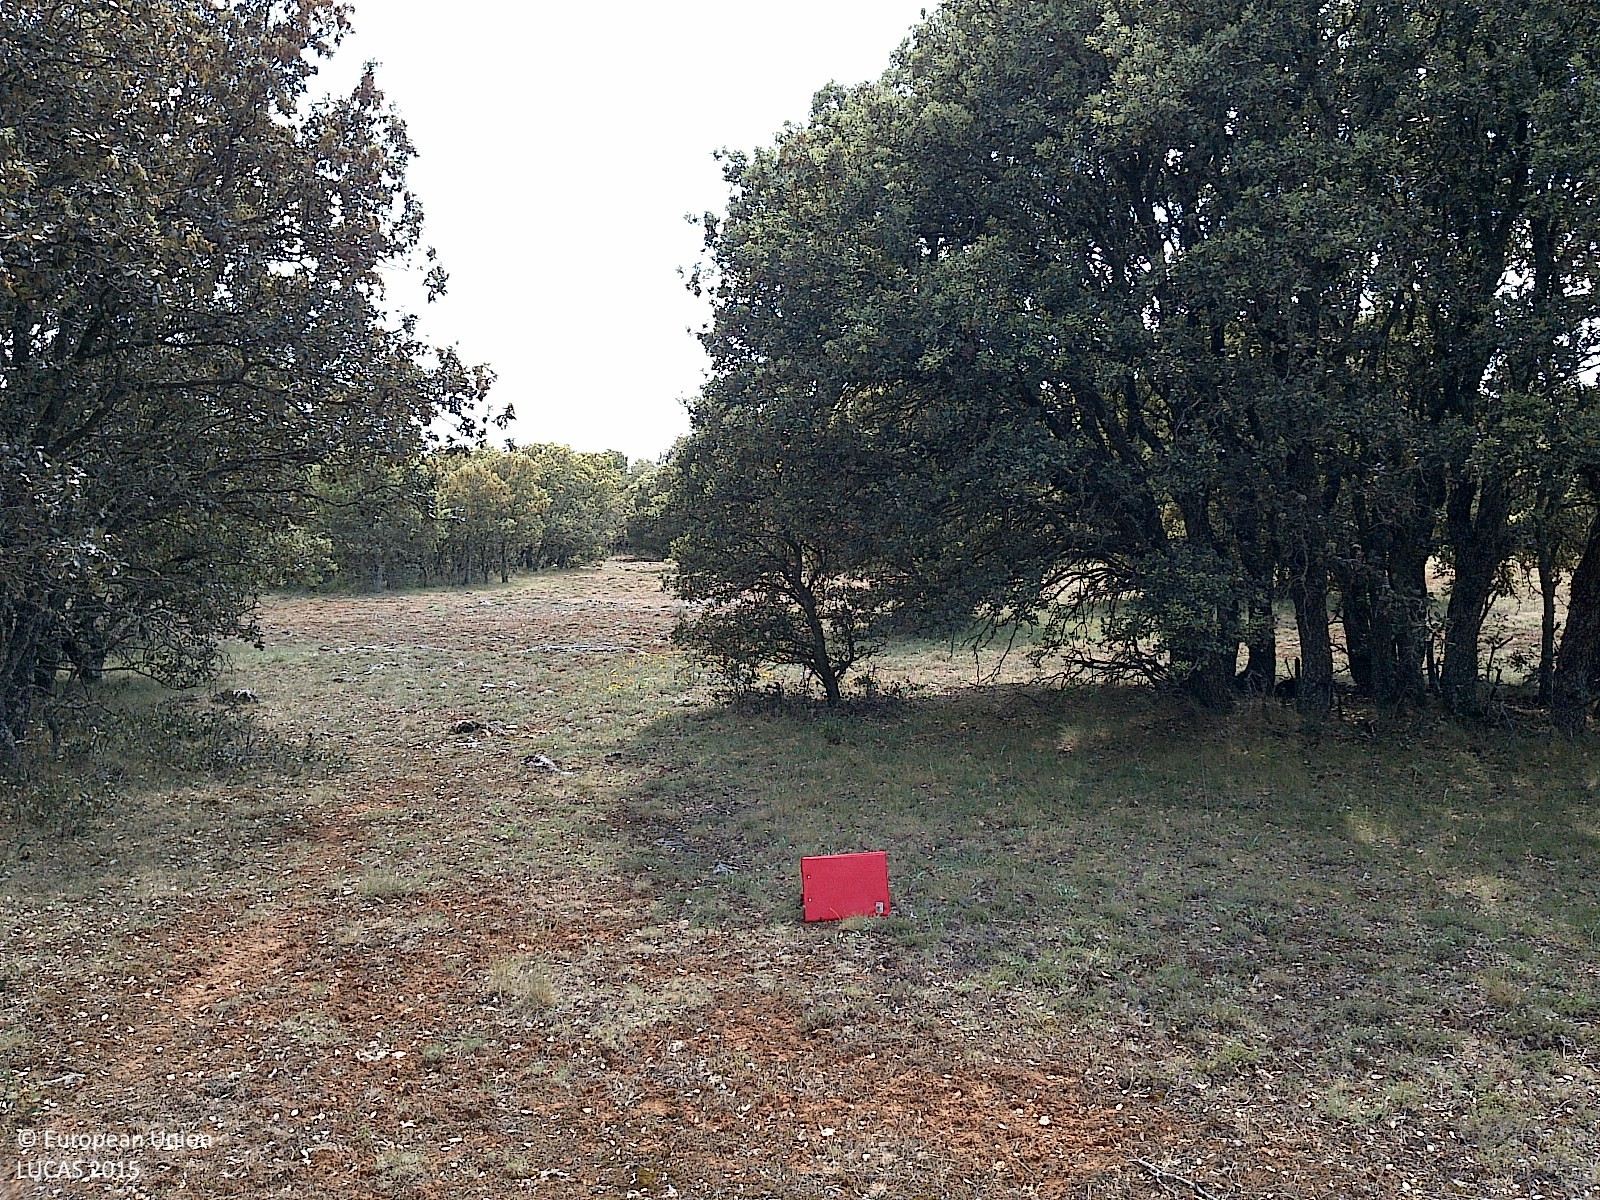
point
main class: Woodland
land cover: Broadleaved woodland
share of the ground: 50 - 75 %
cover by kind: broadleaved forest trees 50 %, herbaceous plants 40 %, consolidated bare surface 5 %, unconsolidated bare surface 5 %
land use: Forestry
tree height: < 5 m
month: June
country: ES
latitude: 41.7175
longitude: -2.1621
